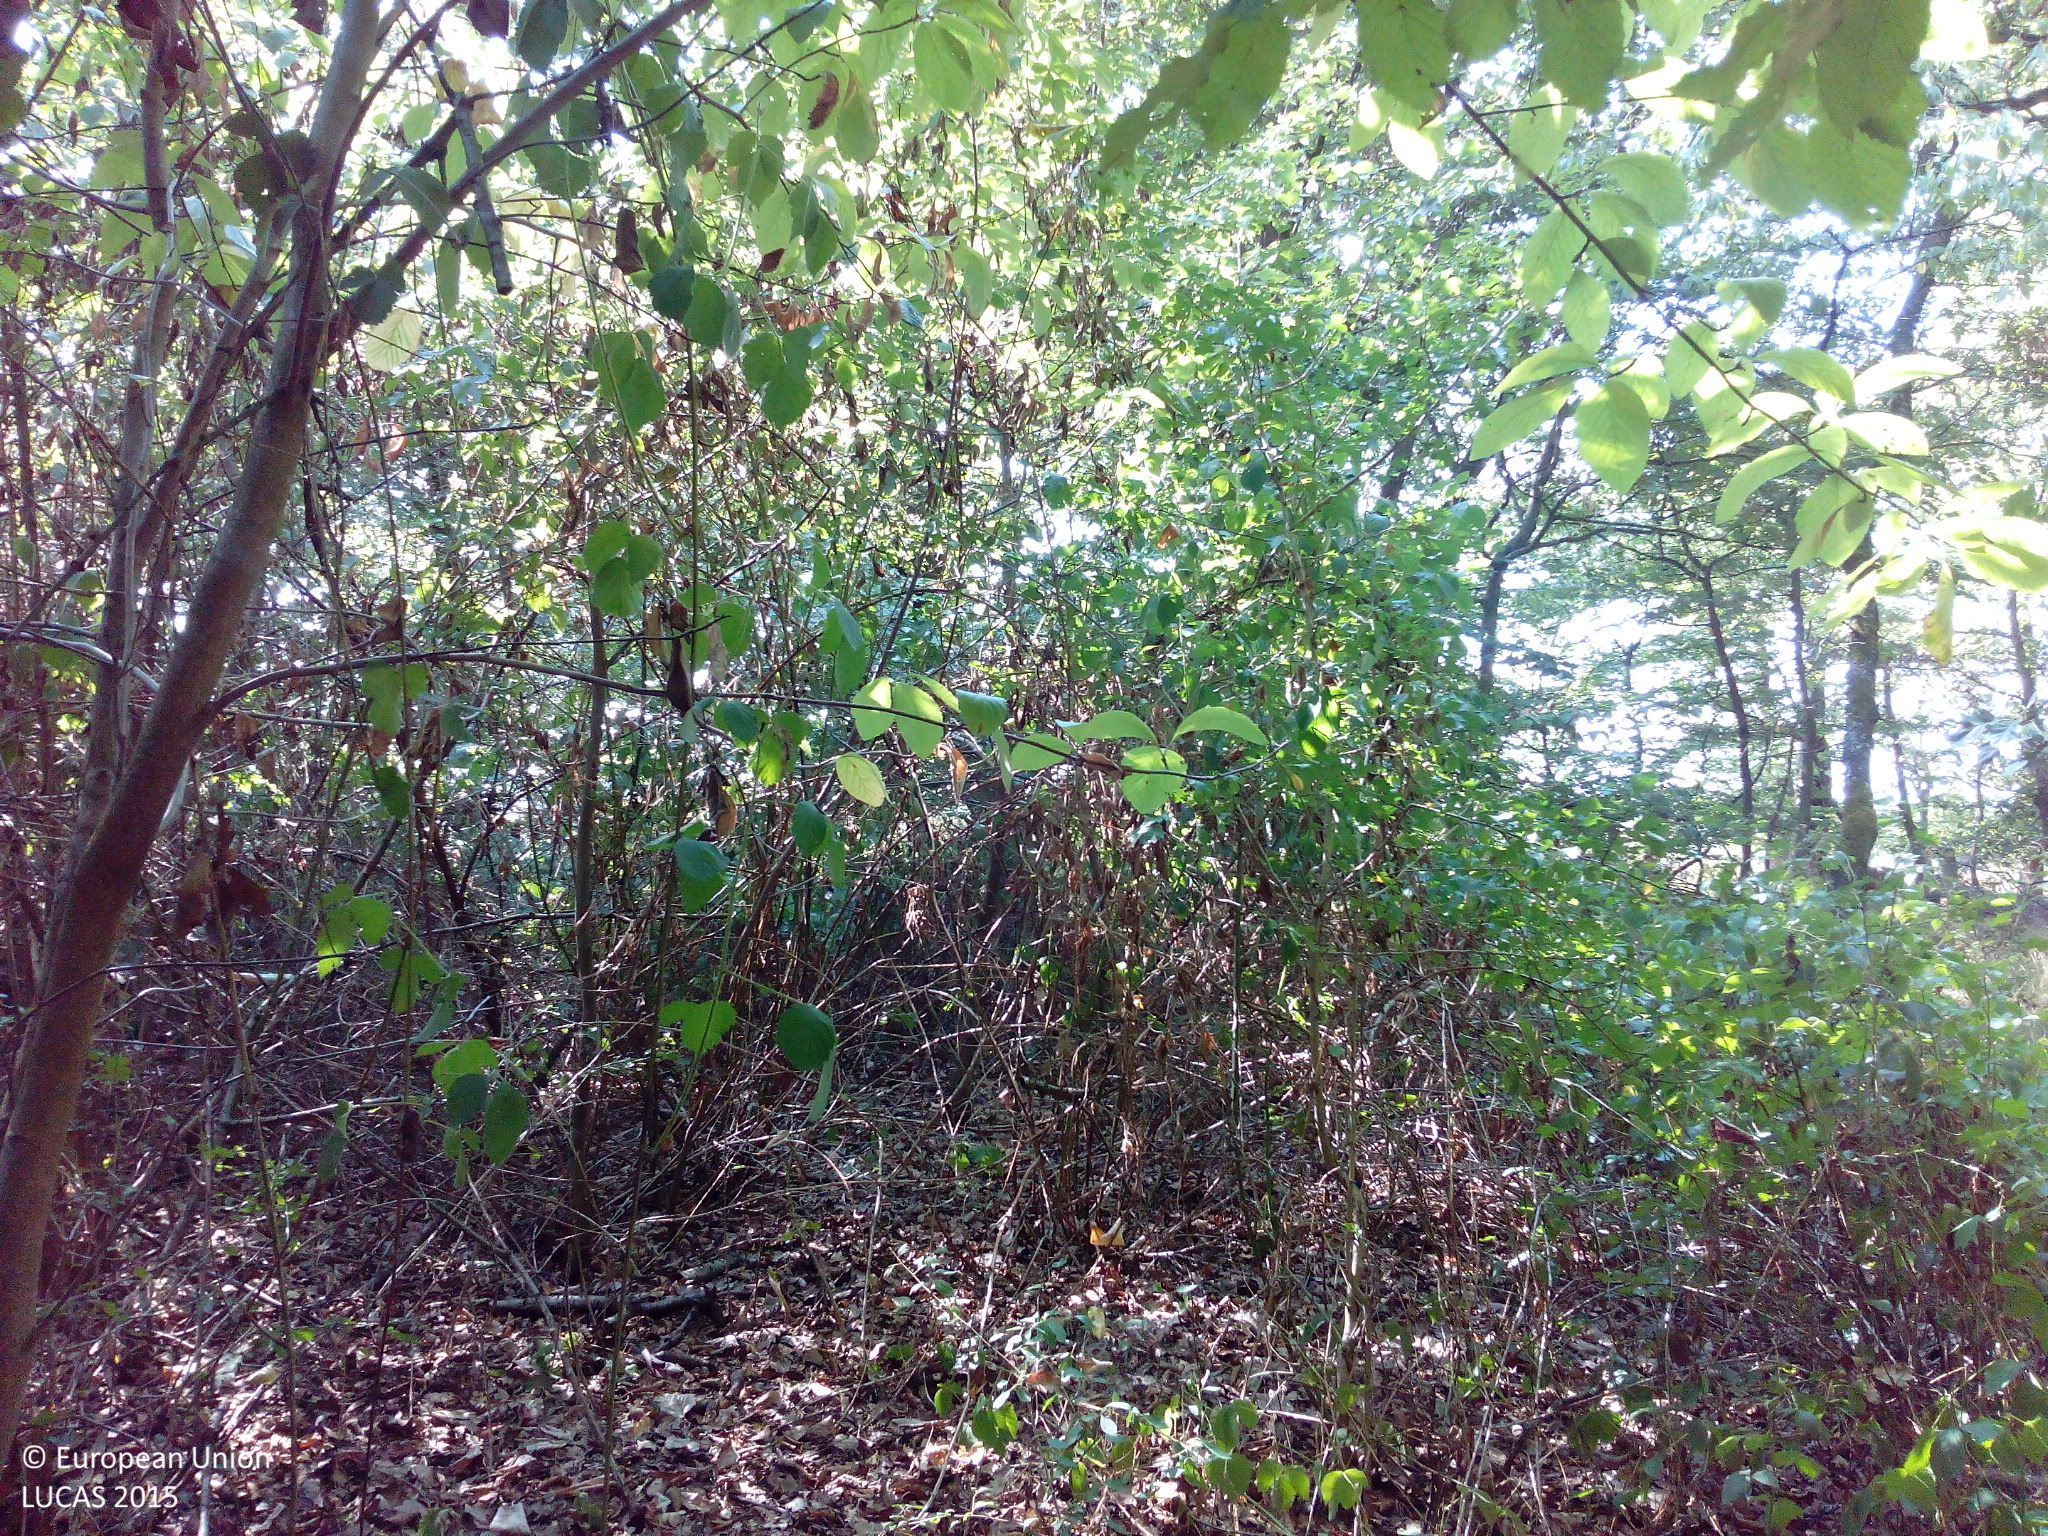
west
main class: Woodland
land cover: Broadleaved woodland
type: mesophytic deciduous forest
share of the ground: > 75 %
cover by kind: broadleaved forest trees 75 %, shrubs 10 %, unconsolidated bare surface 10 %, coniferous forest trees 5 %
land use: Forestry
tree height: > 5 m
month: August
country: DE
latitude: 50.1741
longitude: 7.4659
